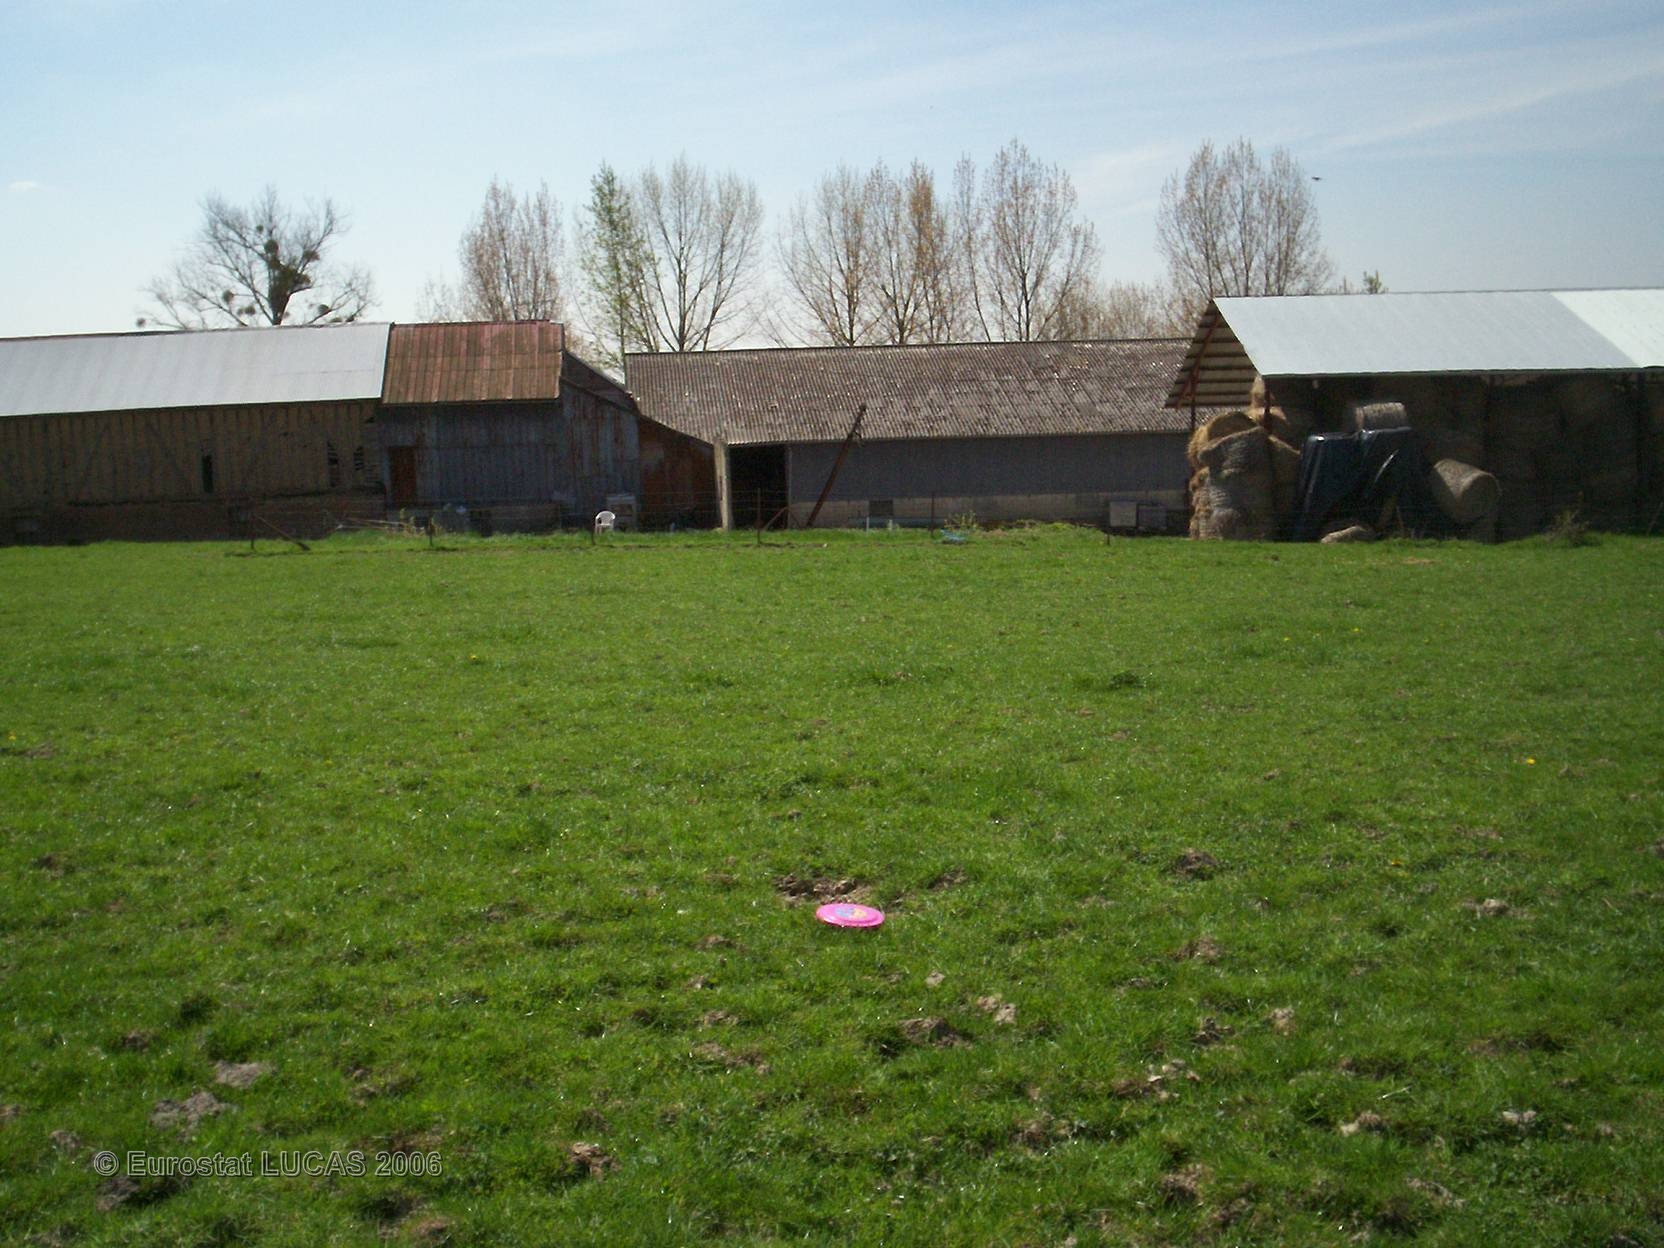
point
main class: Grassland
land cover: Grassland without tree/shrub cover
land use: Agriculture (excluding fallow land and kitchen gardens)
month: April
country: FR
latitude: 49.6825
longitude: 4.3270
